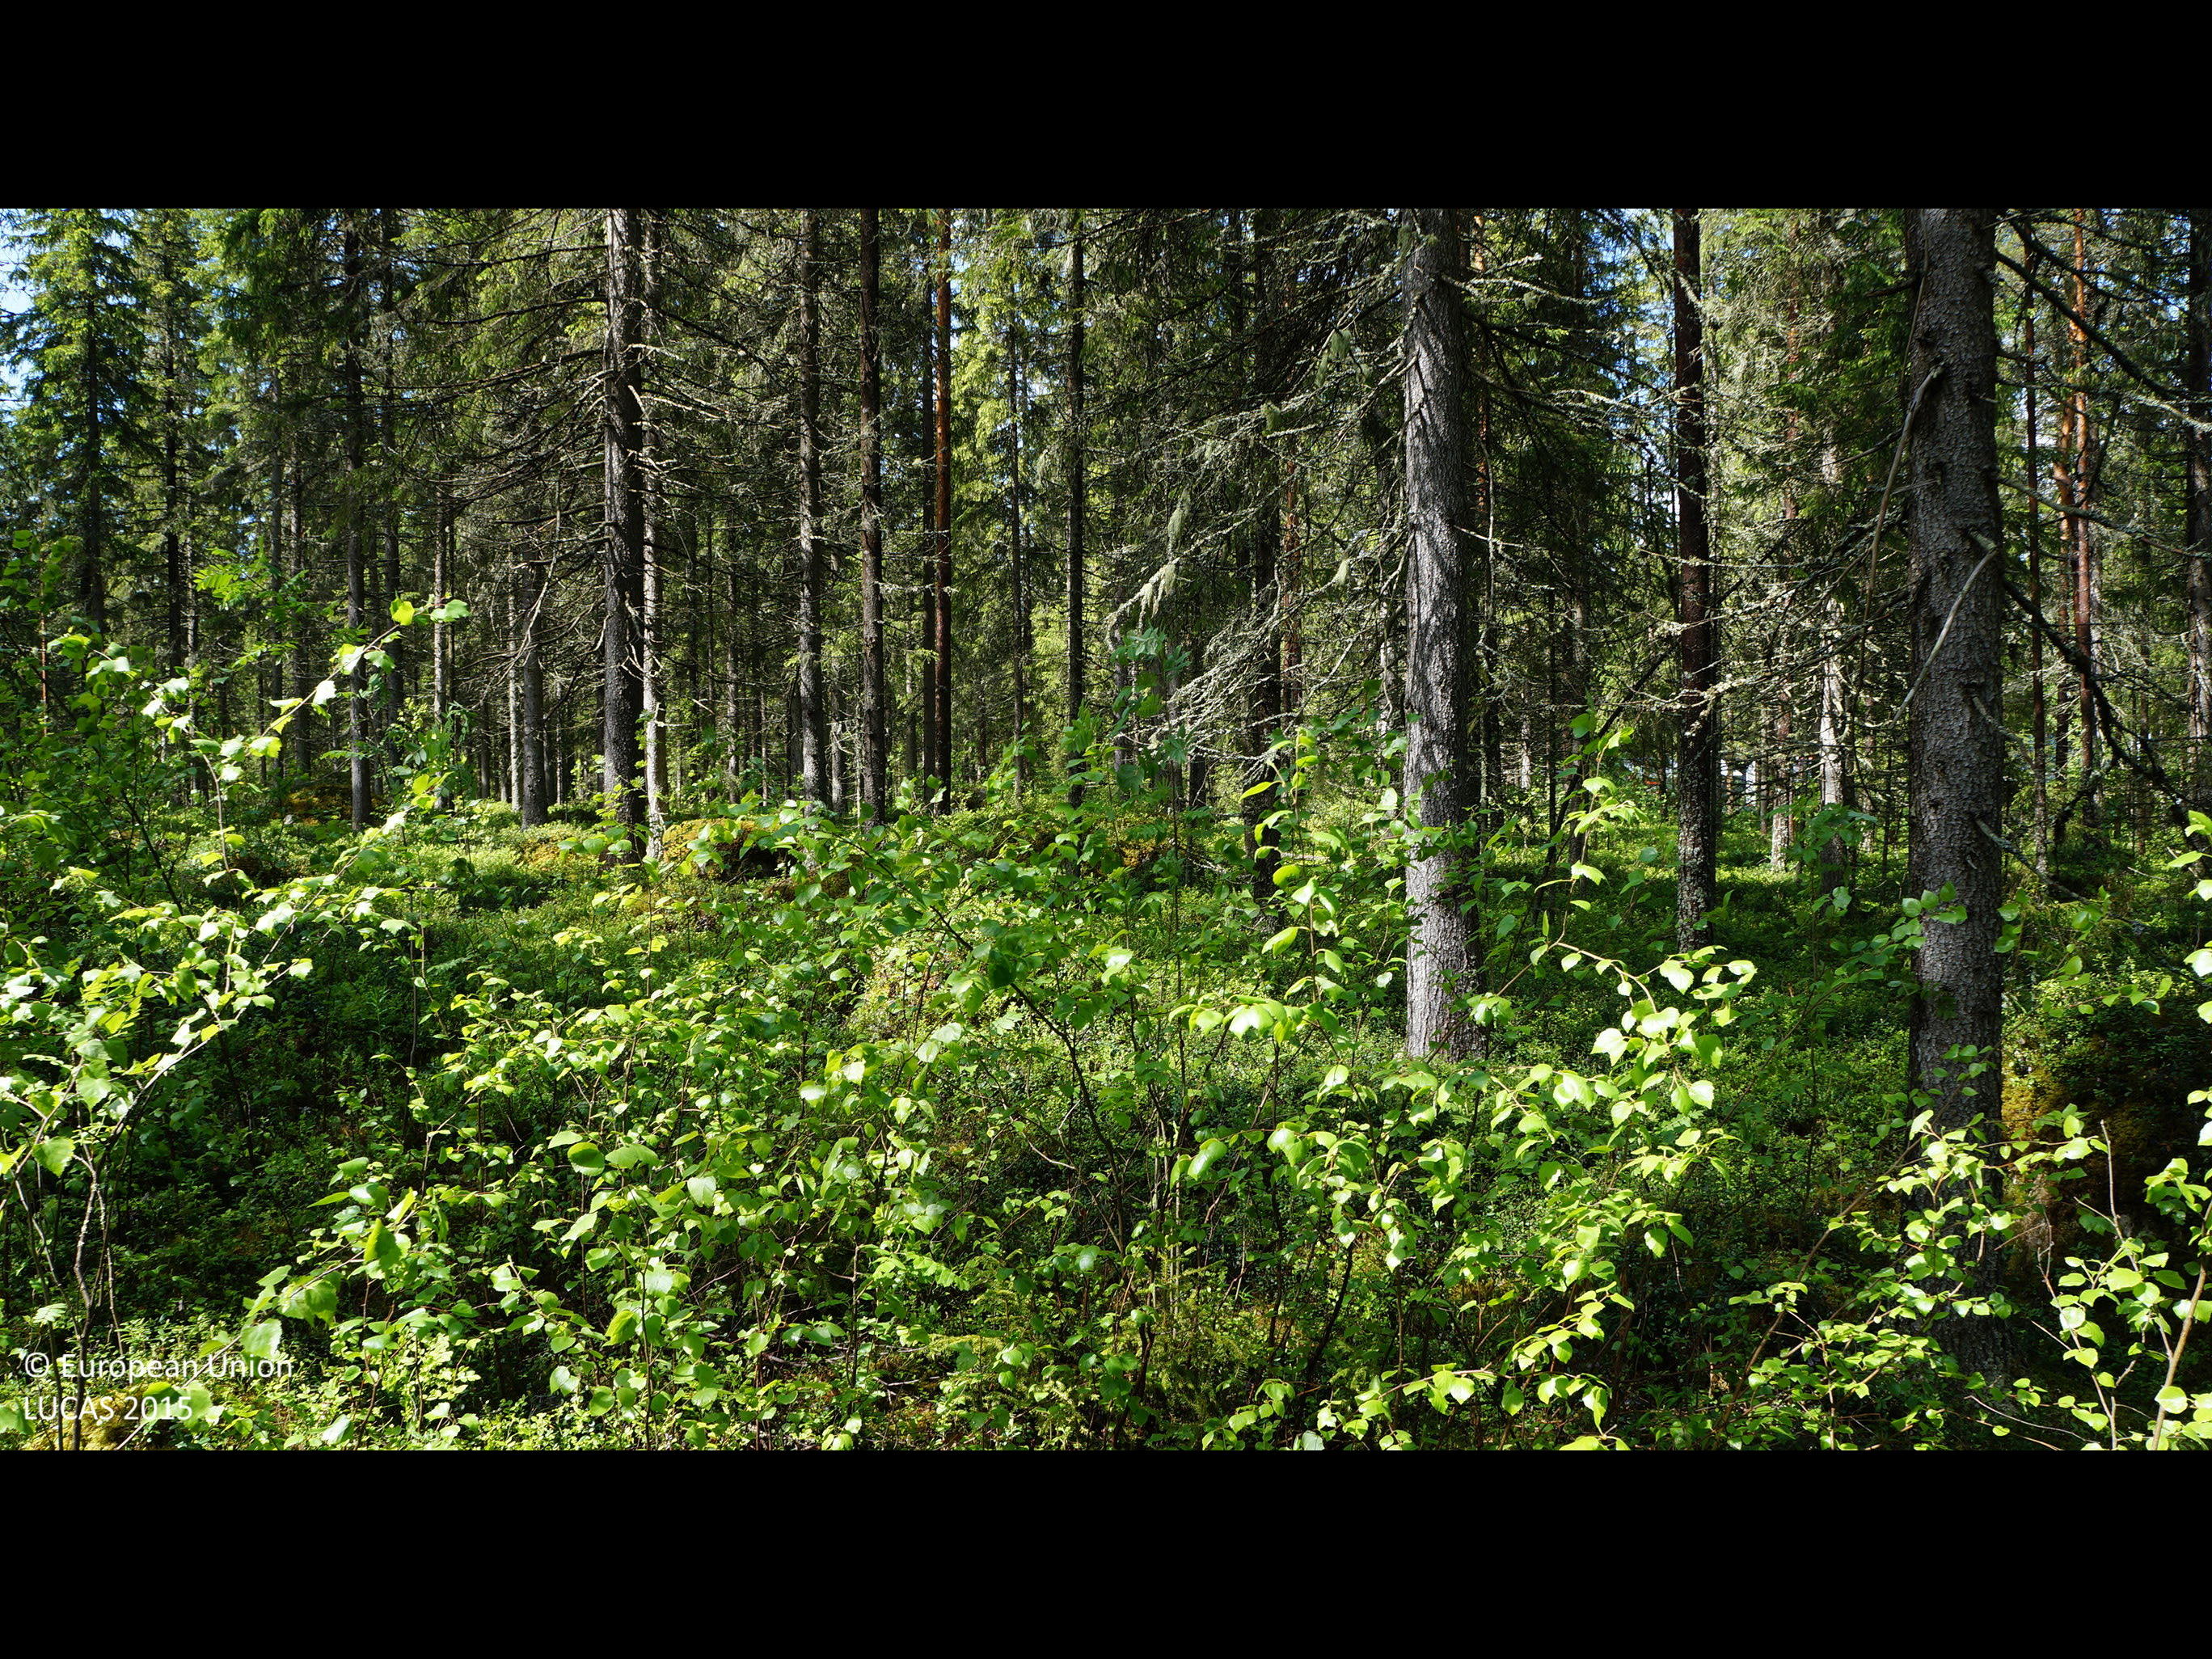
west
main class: Woodland
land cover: Spruce dominated coniferous woodland
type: boreal forest
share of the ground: > 75 %
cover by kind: coniferous forest trees 75 %, herbaceous plants 10 %, broadleaved forest trees 5 %, shrubs 5 %, lichens and mosses 5 %
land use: Forestry
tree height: > 5 m
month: June
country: FI
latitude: 64.0874
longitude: 23.7819
